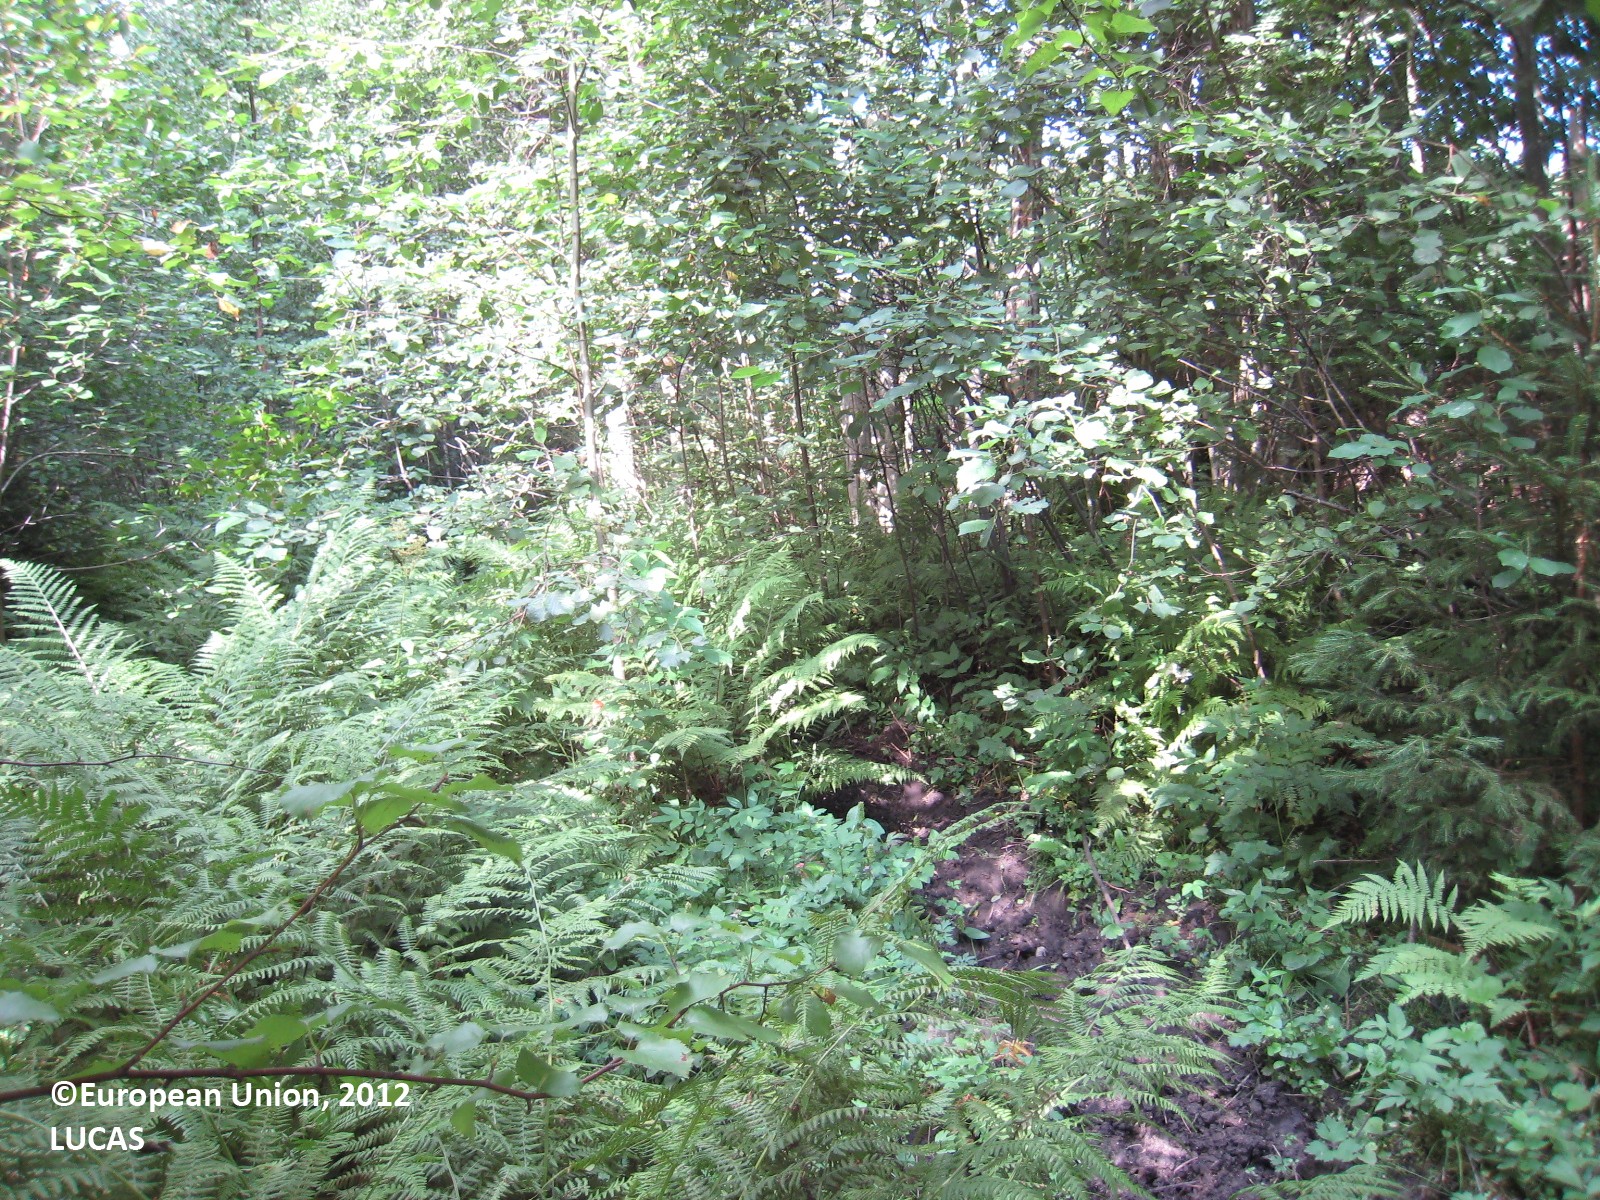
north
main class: Woodland
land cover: Broadleaved woodland
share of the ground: > 75 %
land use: Forestry
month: July
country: FI
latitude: 61.6988
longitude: 26.1117
